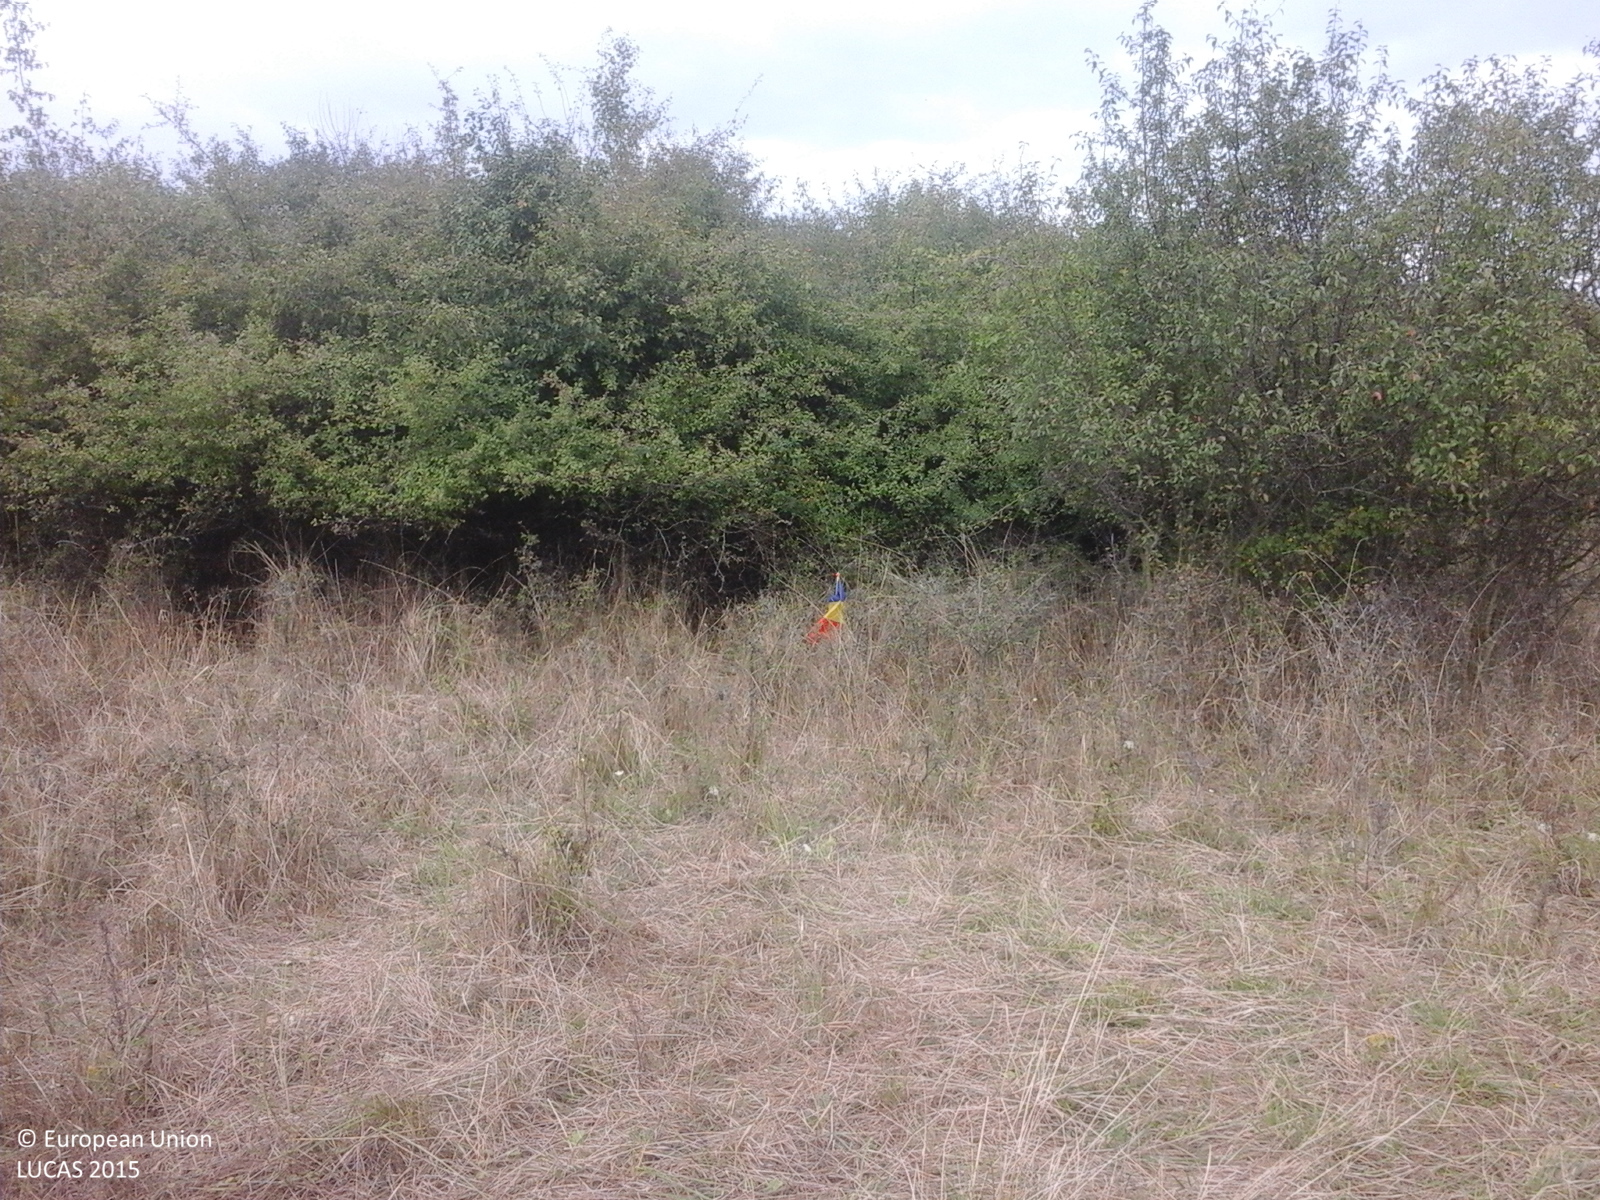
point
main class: Grassland
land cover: Grassland with sparse tree/shrub cover
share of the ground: > 75 %
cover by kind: herbaceous plants 85 %, shrubs 10 %, broadleaved forest trees 5 %
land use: Agriculture (excluding fallow land and kitchen gardens)
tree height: < 5 m
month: August
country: RO
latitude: 45.4215
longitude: 21.3143
